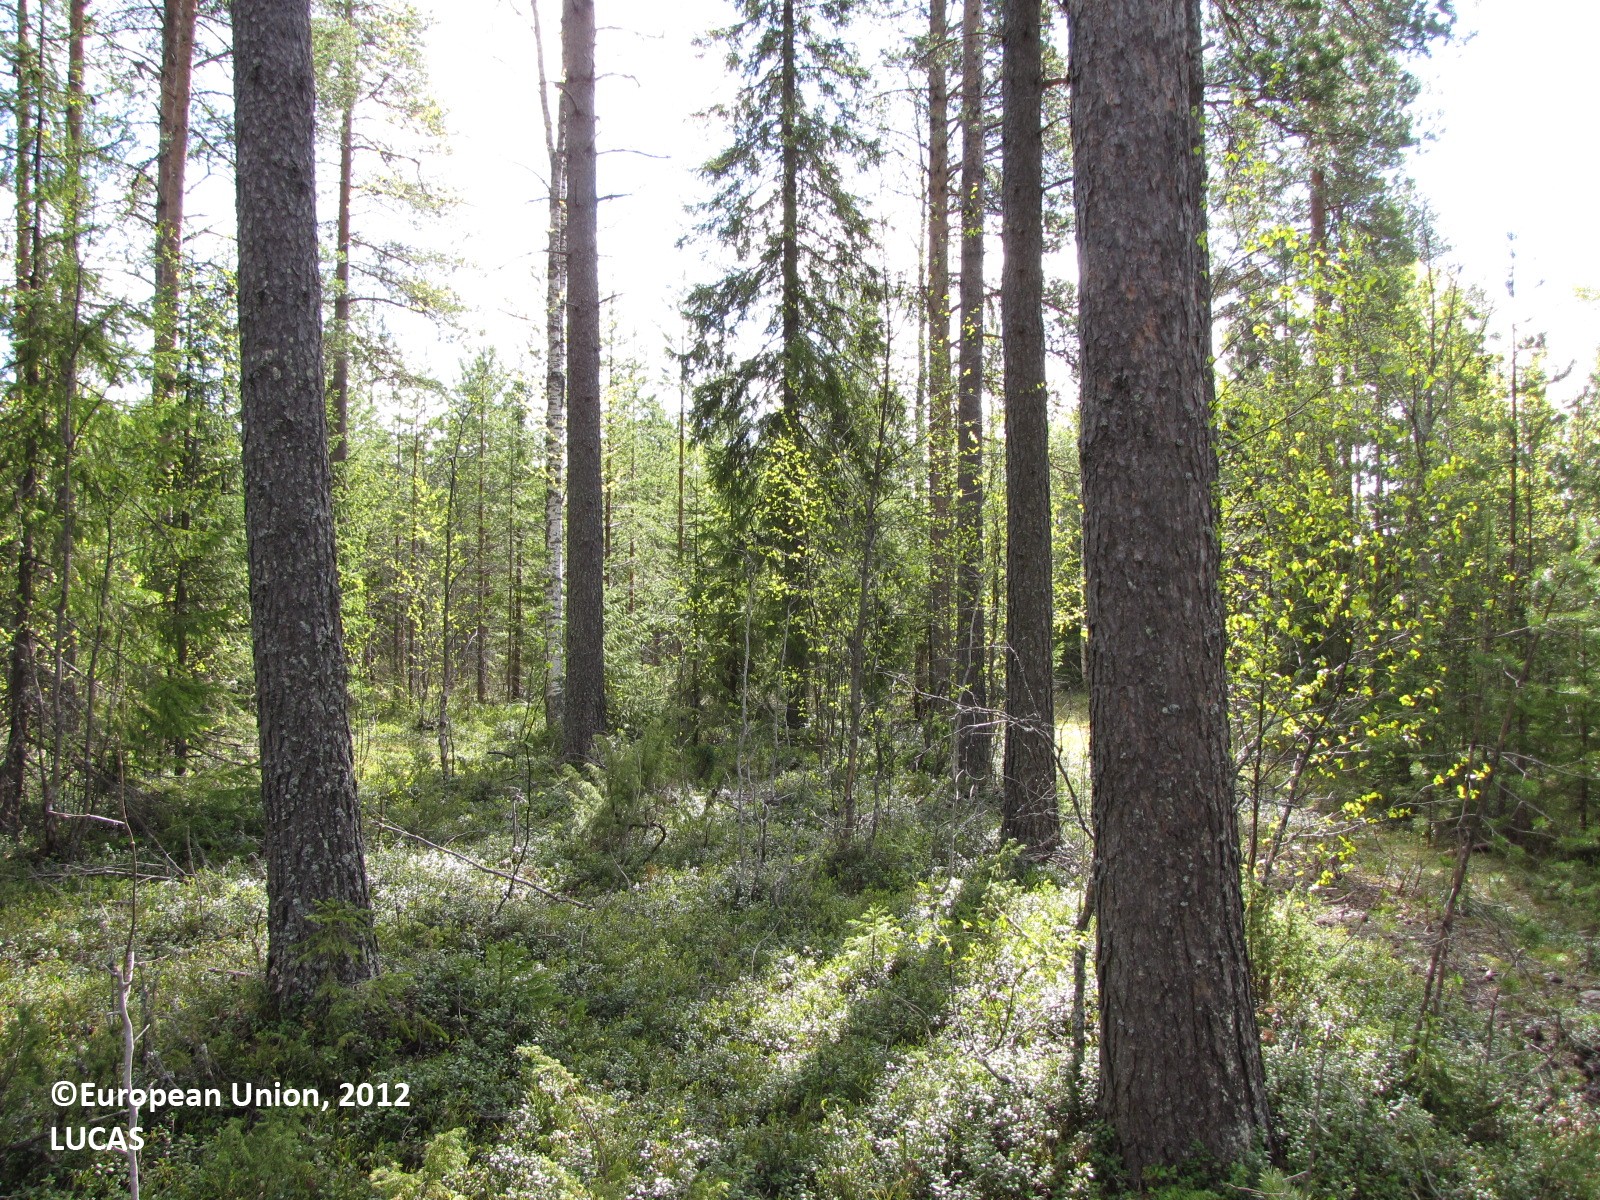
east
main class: Woodland
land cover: Pine dominated mixed woodland
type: boreal forest
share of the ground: > 75 %
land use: Forestry
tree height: > 5 m
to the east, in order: Pine dominated mixed woodland; Ditches and canals; Pine dominated mixed woodland; Ditches and canals; Pine dominated mixed woodland; Ditches and canals; Pine dominated mixed woodland; Spruce dominated coniferous woodland
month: June
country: FI
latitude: 65.7645
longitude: 24.6184
